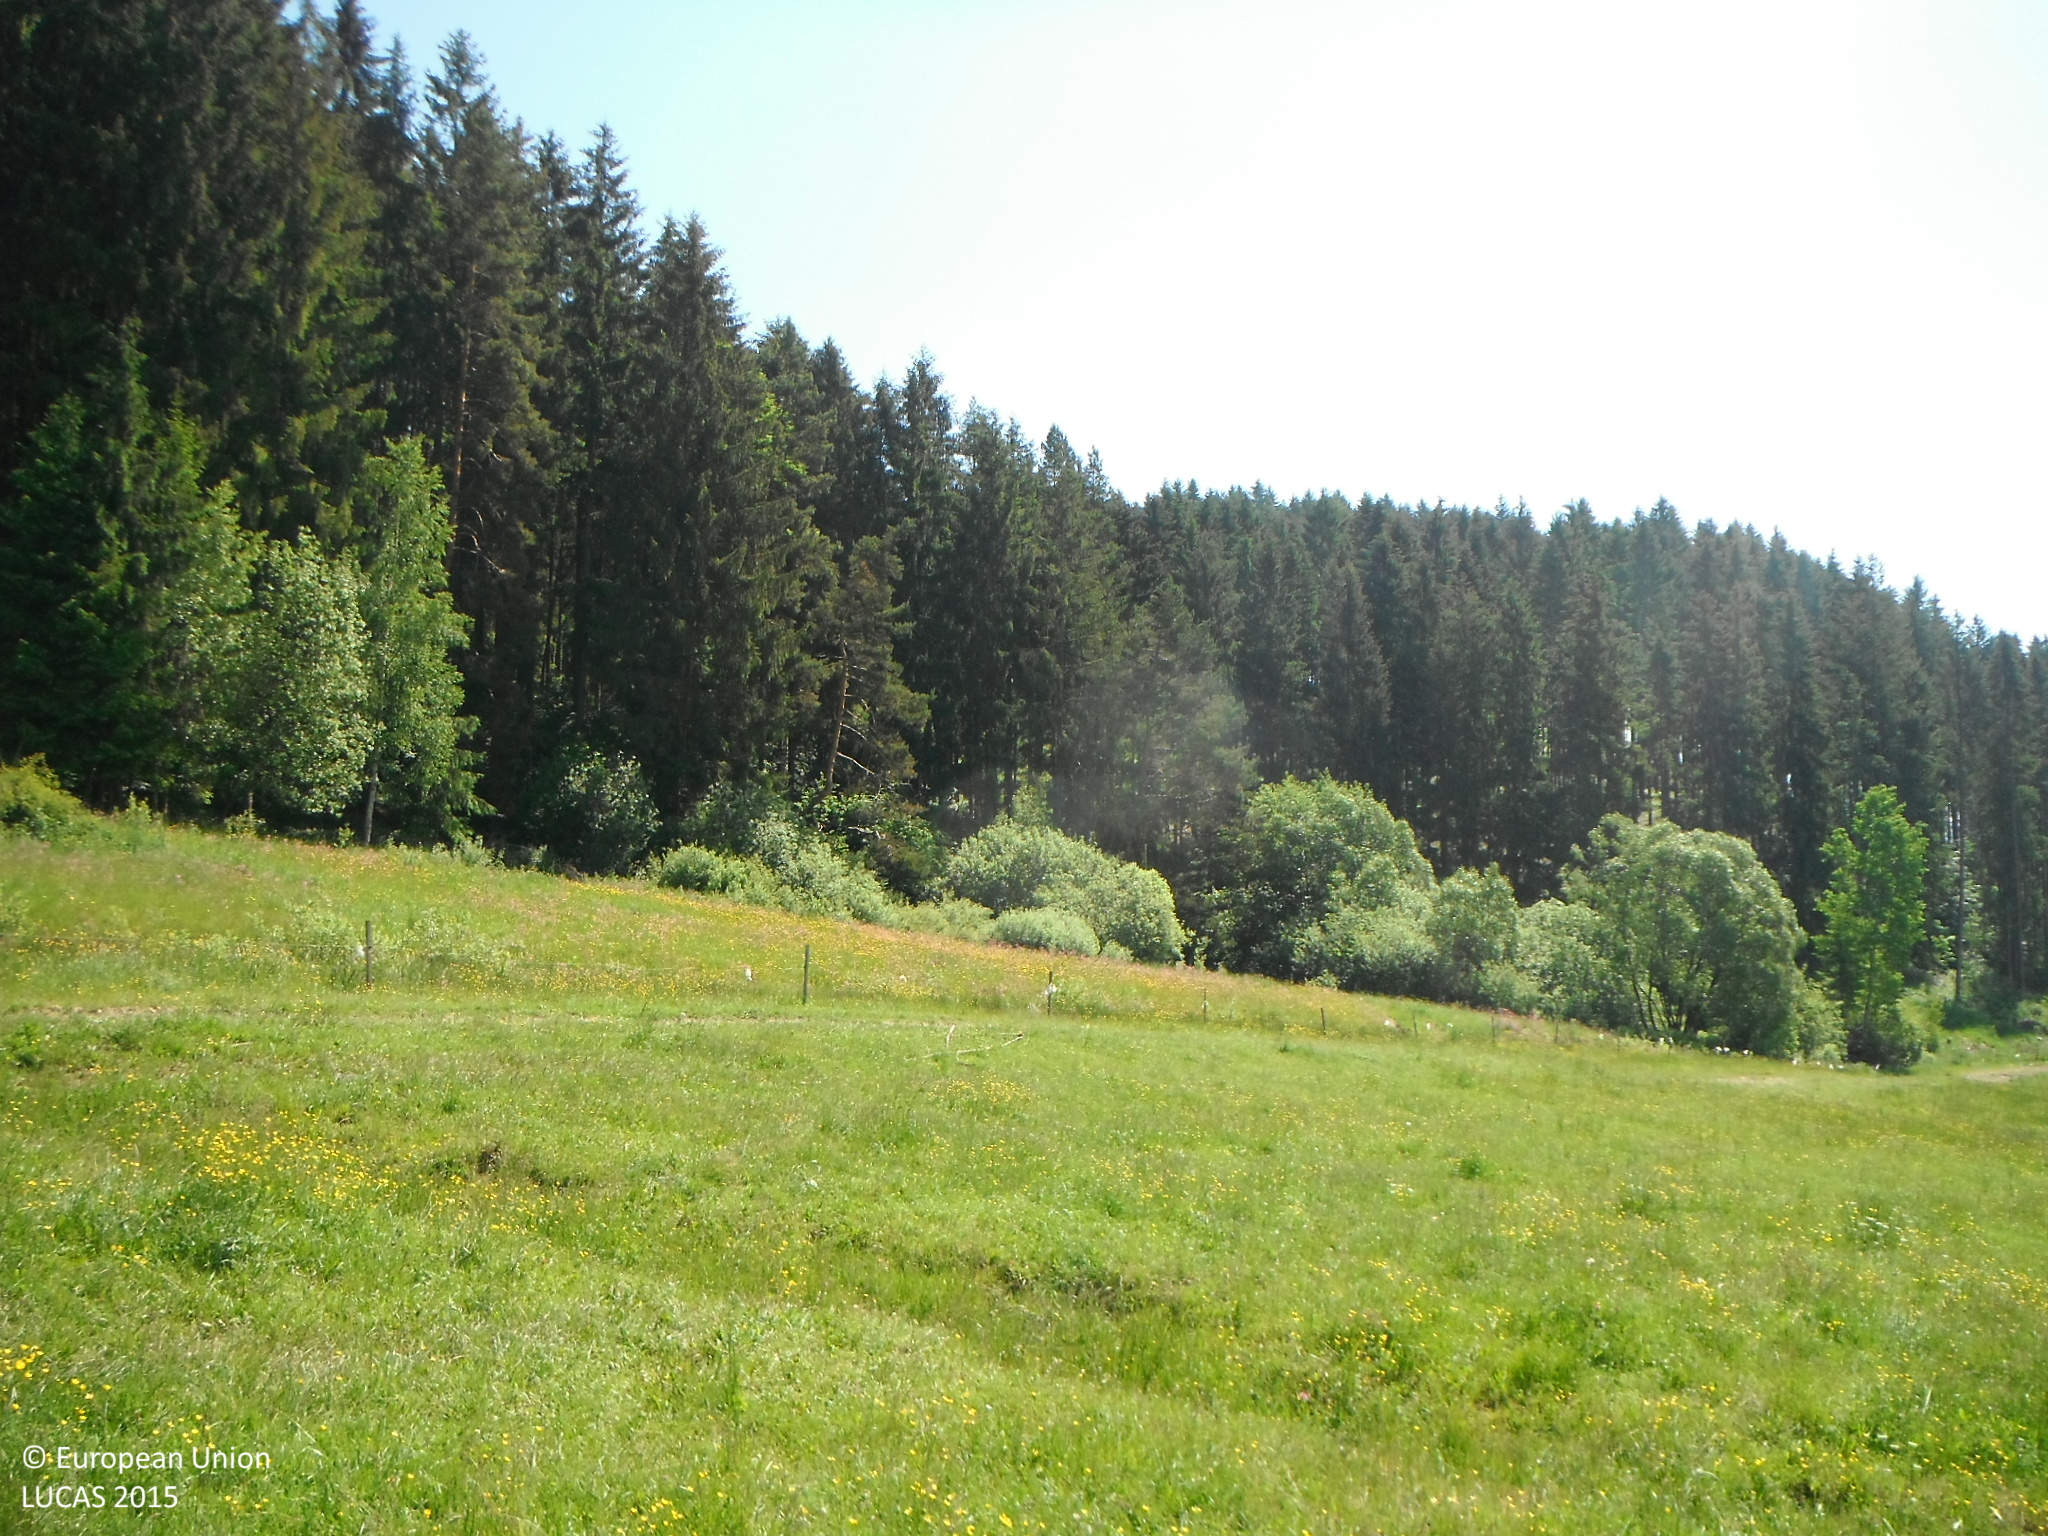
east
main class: Grassland
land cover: Grassland without tree/shrub cover
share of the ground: > 75 %
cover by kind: herbaceous plants 100 %
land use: Agriculture (excluding fallow land and kitchen gardens)
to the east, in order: Grassland without tree/shrub cover; Tracks; Fences; Grassland without tree/shrub cover; Shrubland without tree cover; Spruce dominated coniferous woodland; Spontaneously vegetated surfaces; Rivers and streams; Spruce dominated coniferous woodland; Shrubland without tree cover
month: June
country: SK
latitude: 48.7863
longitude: 19.7595
